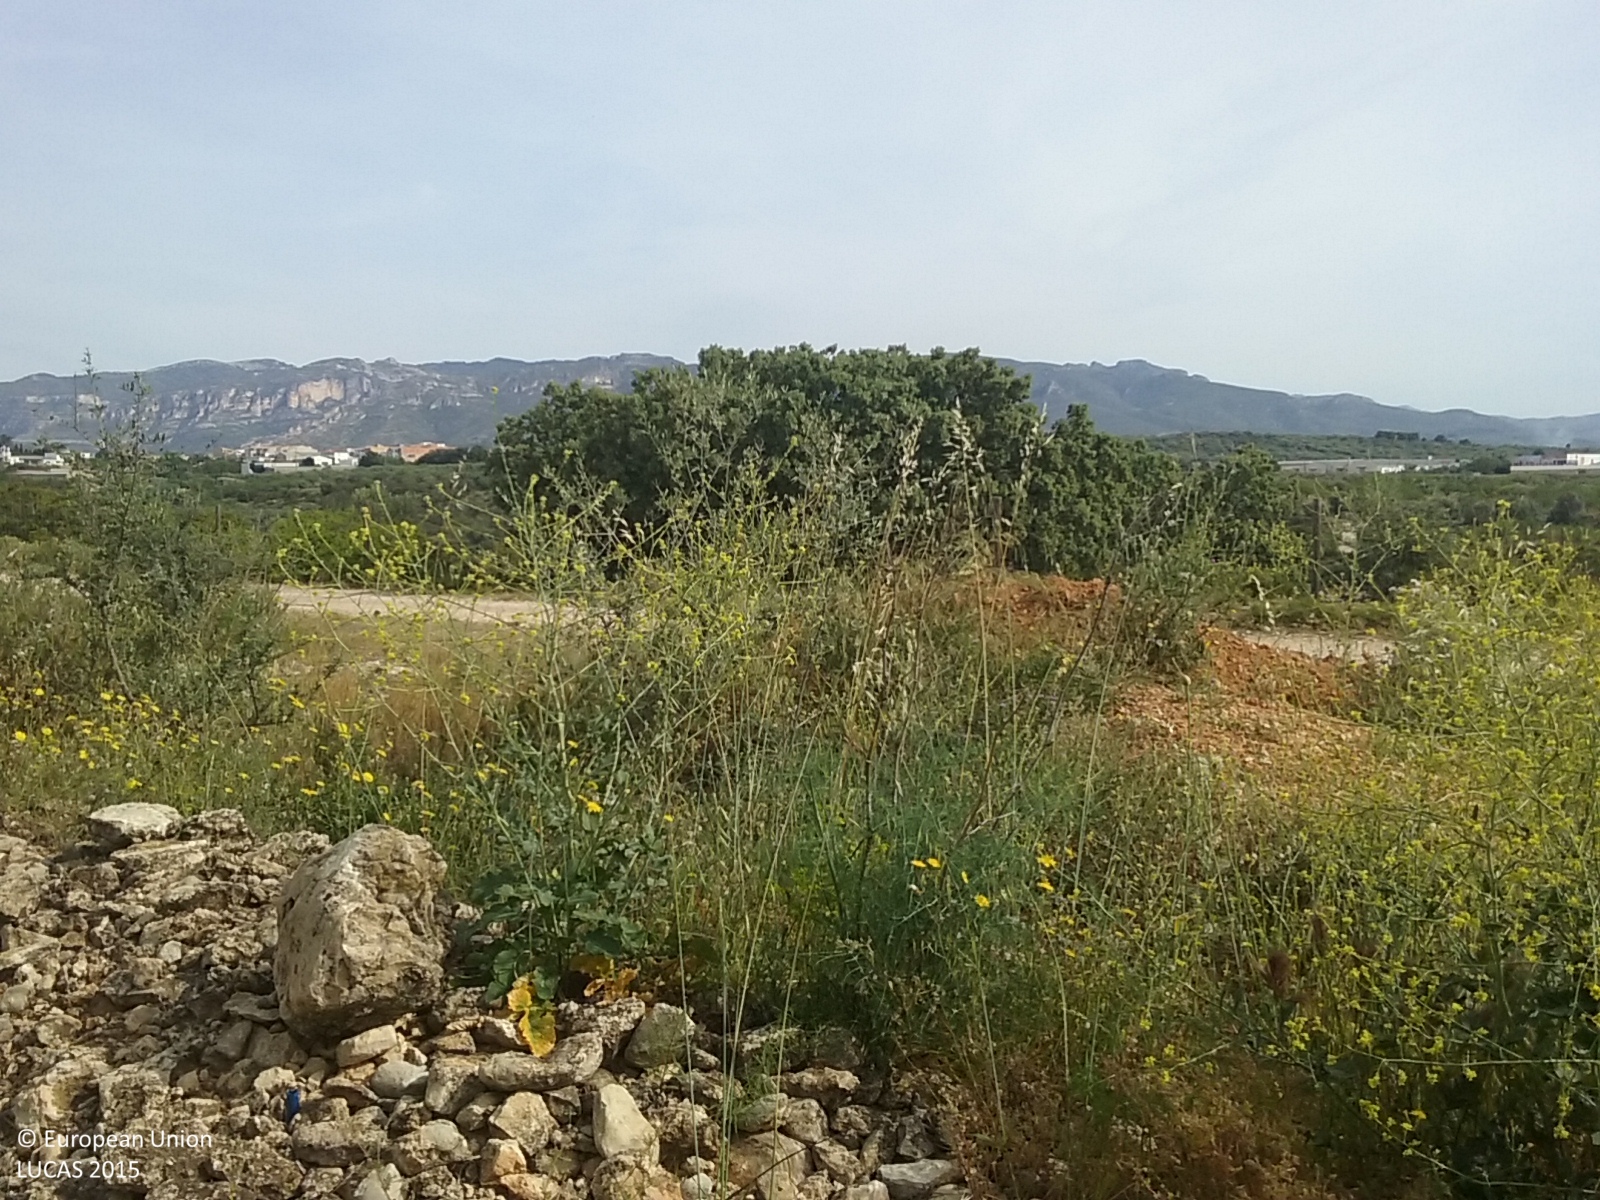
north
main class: Cropland
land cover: Olive groves
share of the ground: 25 - 50 %
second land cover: Spontaneously vegetated surfaces
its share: 25 - 50 %
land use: Agriculture (excluding fallow land and kitchen gardens)
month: May
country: ES
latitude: 40.6221
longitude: 0.2893
